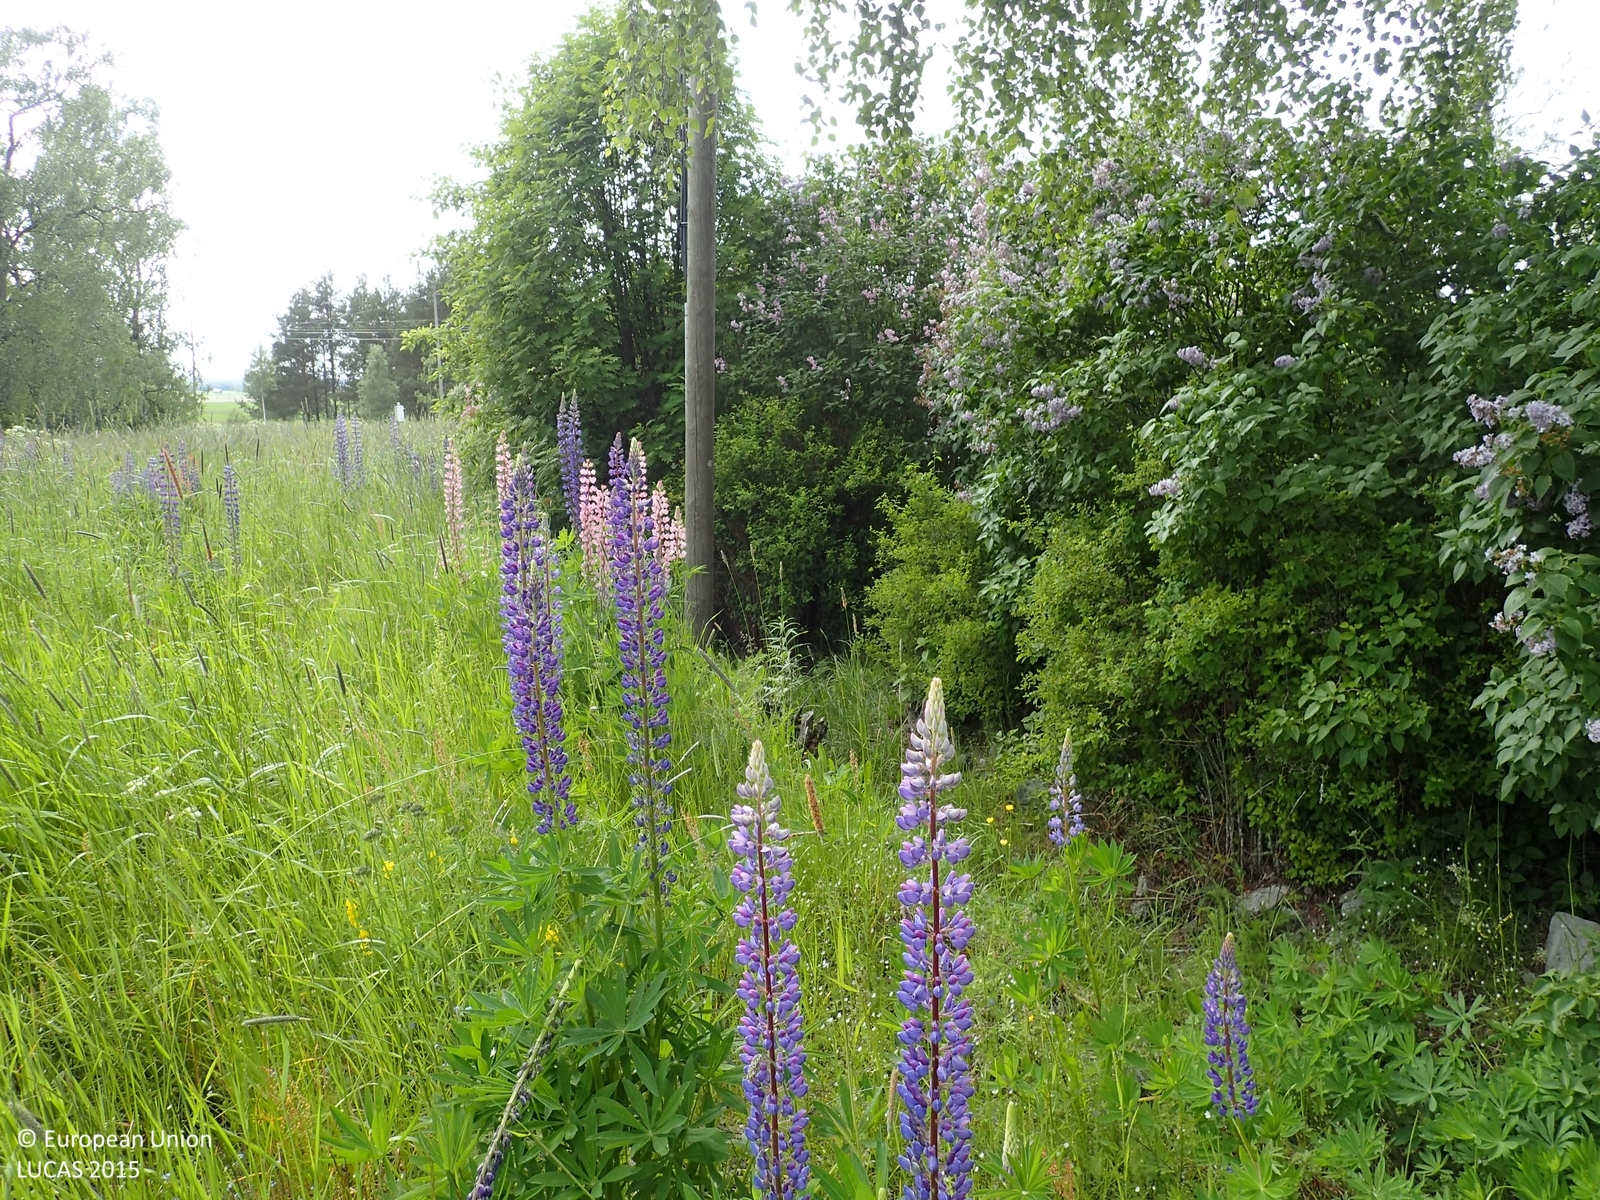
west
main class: Grassland
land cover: Grassland without tree/shrub cover
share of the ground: > 75 %
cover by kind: herbaceous plants 100 %
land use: Residential
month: June
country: FI
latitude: 62.5391
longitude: 21.4526
